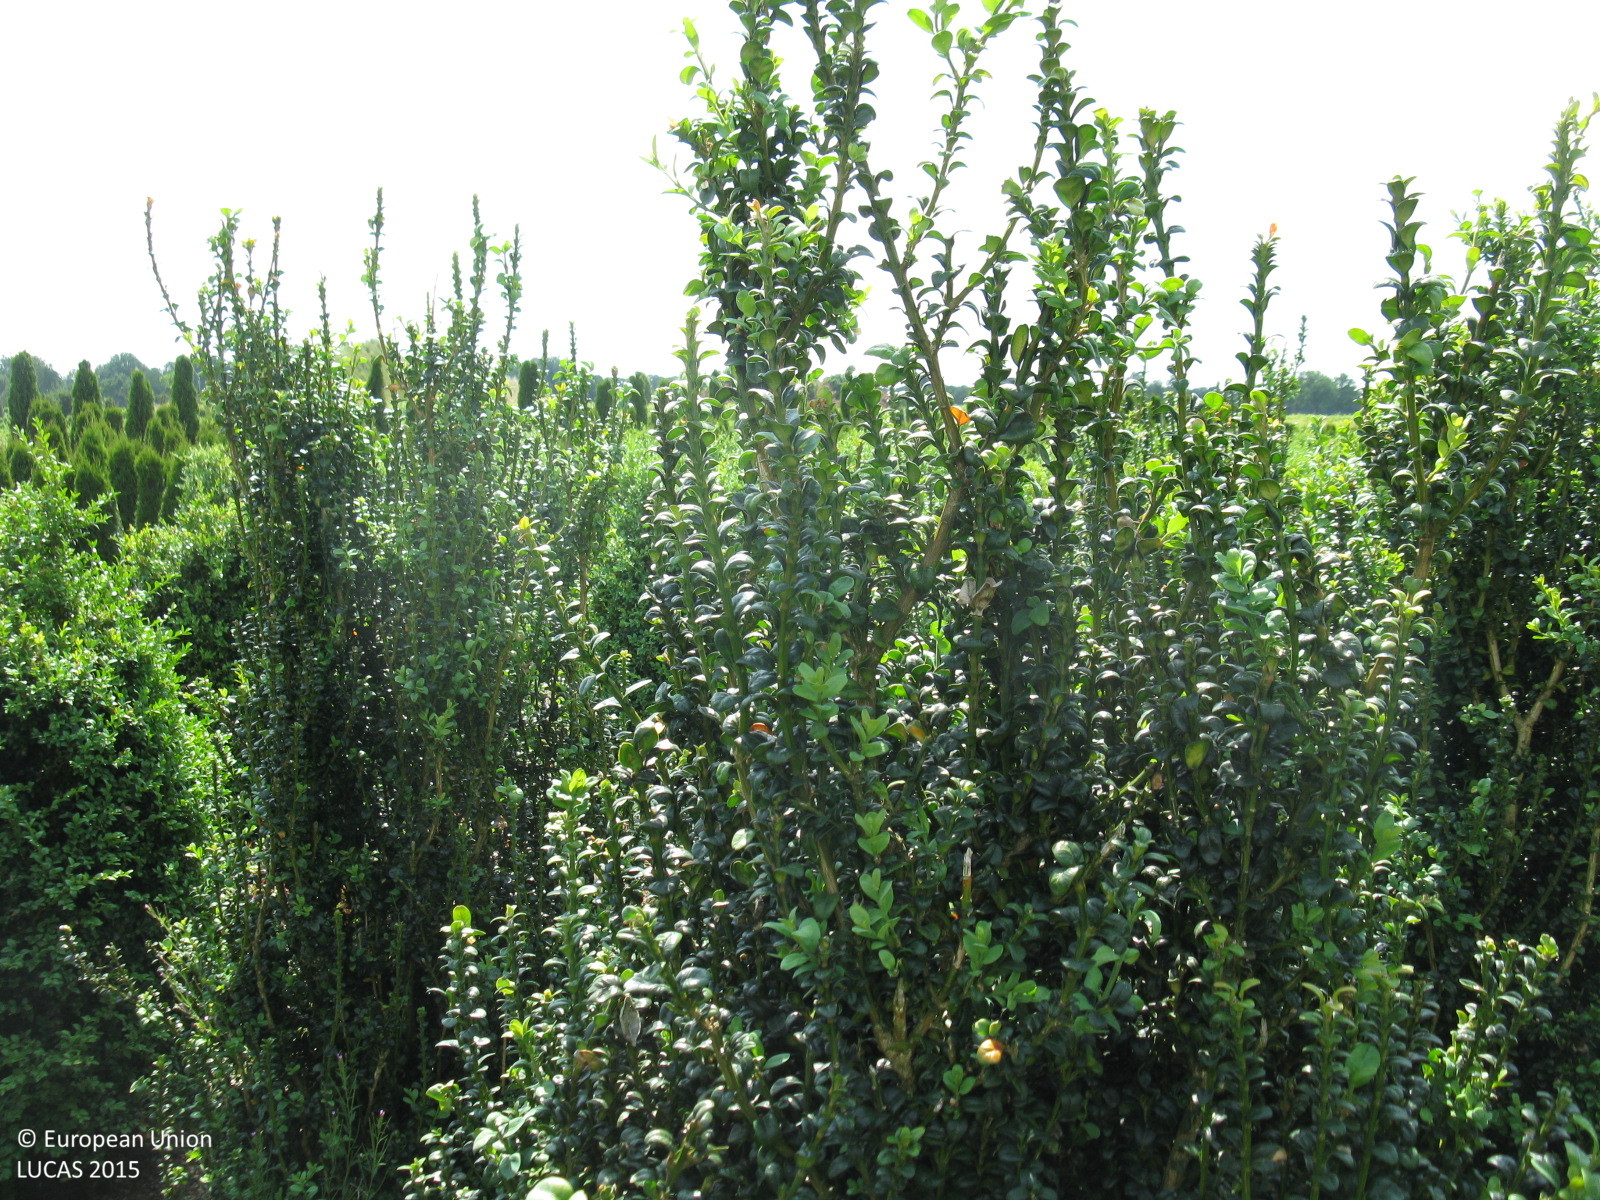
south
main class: Cropland
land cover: Nurseries
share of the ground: > 75 %
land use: Agriculture (excluding fallow land and kitchen gardens)
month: July
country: DE
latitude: 53.3300
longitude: 7.9135
